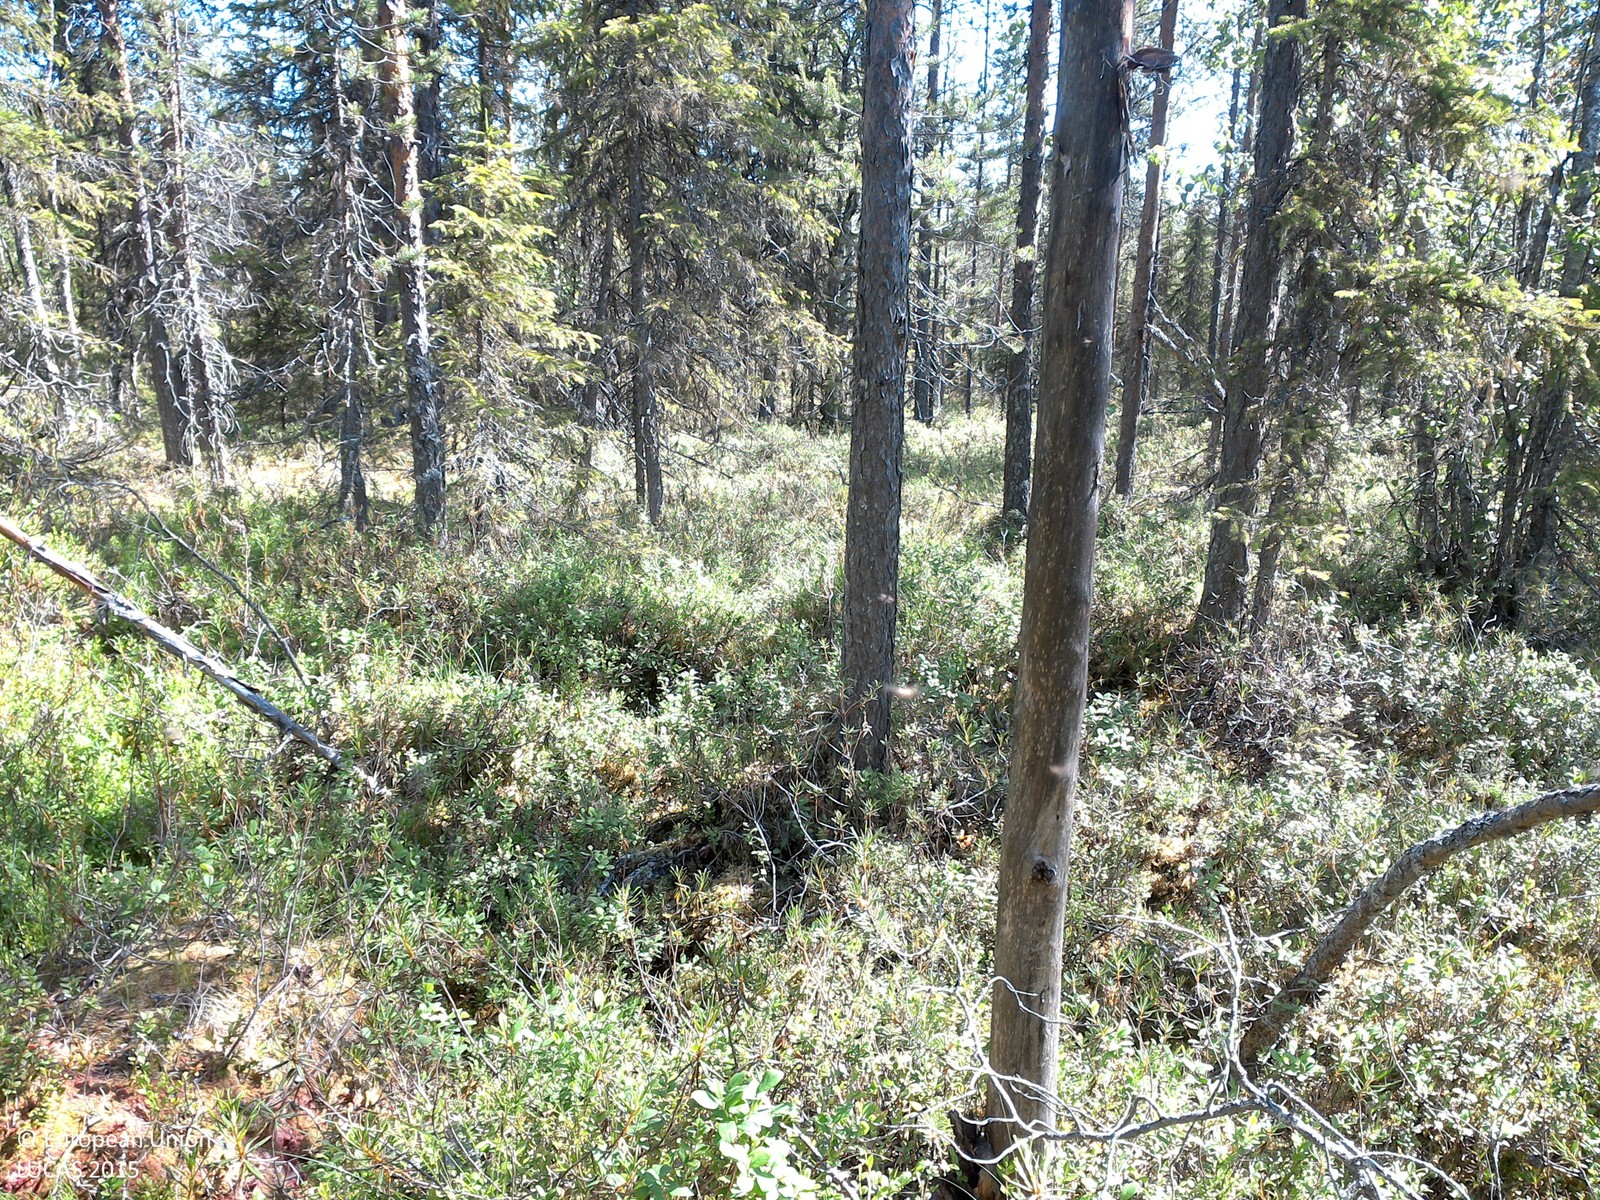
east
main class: Woodland
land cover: Pine dominated coniferous woodland
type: boreal forest
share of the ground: 25 - 50 %
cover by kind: shrubs 65 %, coniferous forest trees 20 %, lichens and mosses 10 %, broadleaved forest trees 5 %
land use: Forestry
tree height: > 5 m
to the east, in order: Pine dominated coniferous woodland; Pine dominated mixed woodland; Spruce dominated coniferous woodland; Shrubland with sparse tree cover; Broadleaved woodland; Grass margins; Electric lines; Ditches and canals; Groves; Other mixed woodland; Spruce dominated mixed woodland; Pine dominated coniferous woodland
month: July
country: SE
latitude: 66.7527
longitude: 23.8578
